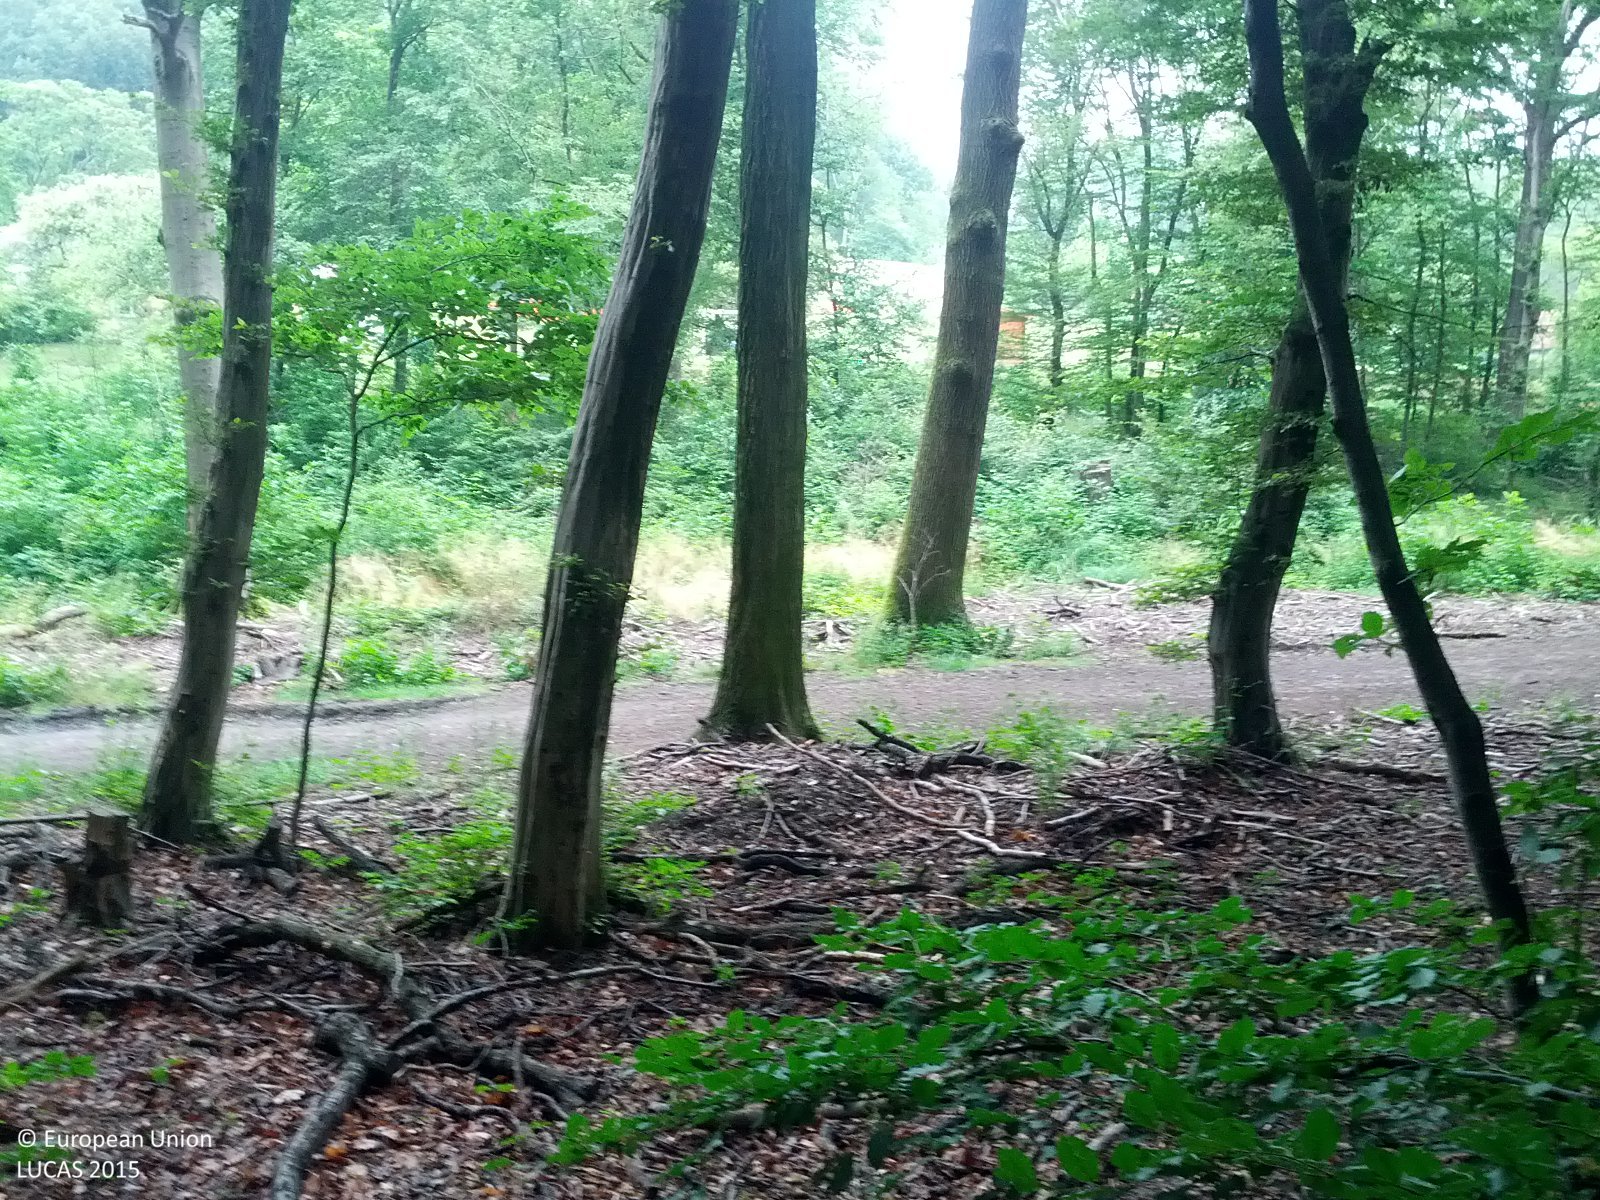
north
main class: Woodland
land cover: Broadleaved woodland
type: beech forest
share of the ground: > 75 %
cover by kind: broadleaved forest trees 90 %, herbaceous plants 10 %
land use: Forestry
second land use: Amenities, museums, leisure
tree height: > 5 m
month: June
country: AT
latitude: 48.2423
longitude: 16.2932
